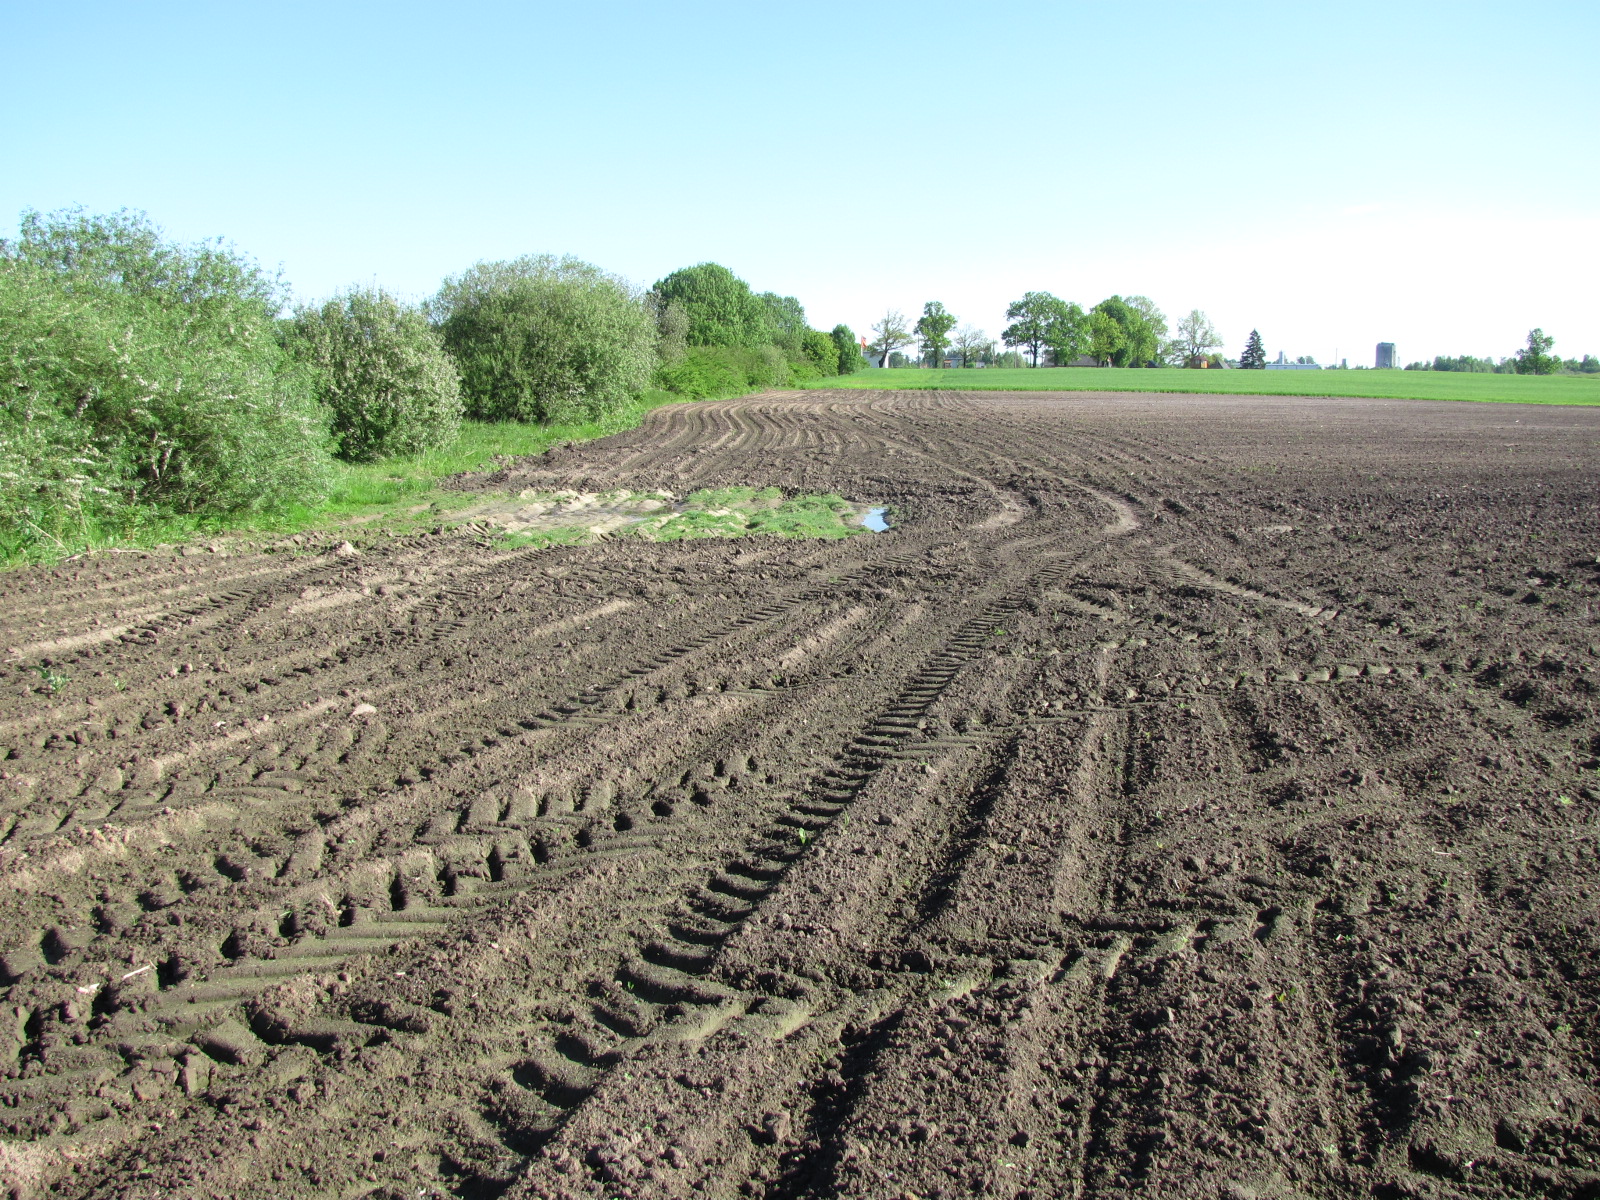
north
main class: Cropland
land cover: Maize
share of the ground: < 10 %
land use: Agriculture (excluding fallow land and kitchen gardens)
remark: Tilled/Sowed
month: May
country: LV
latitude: 56.6162
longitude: 24.2172
